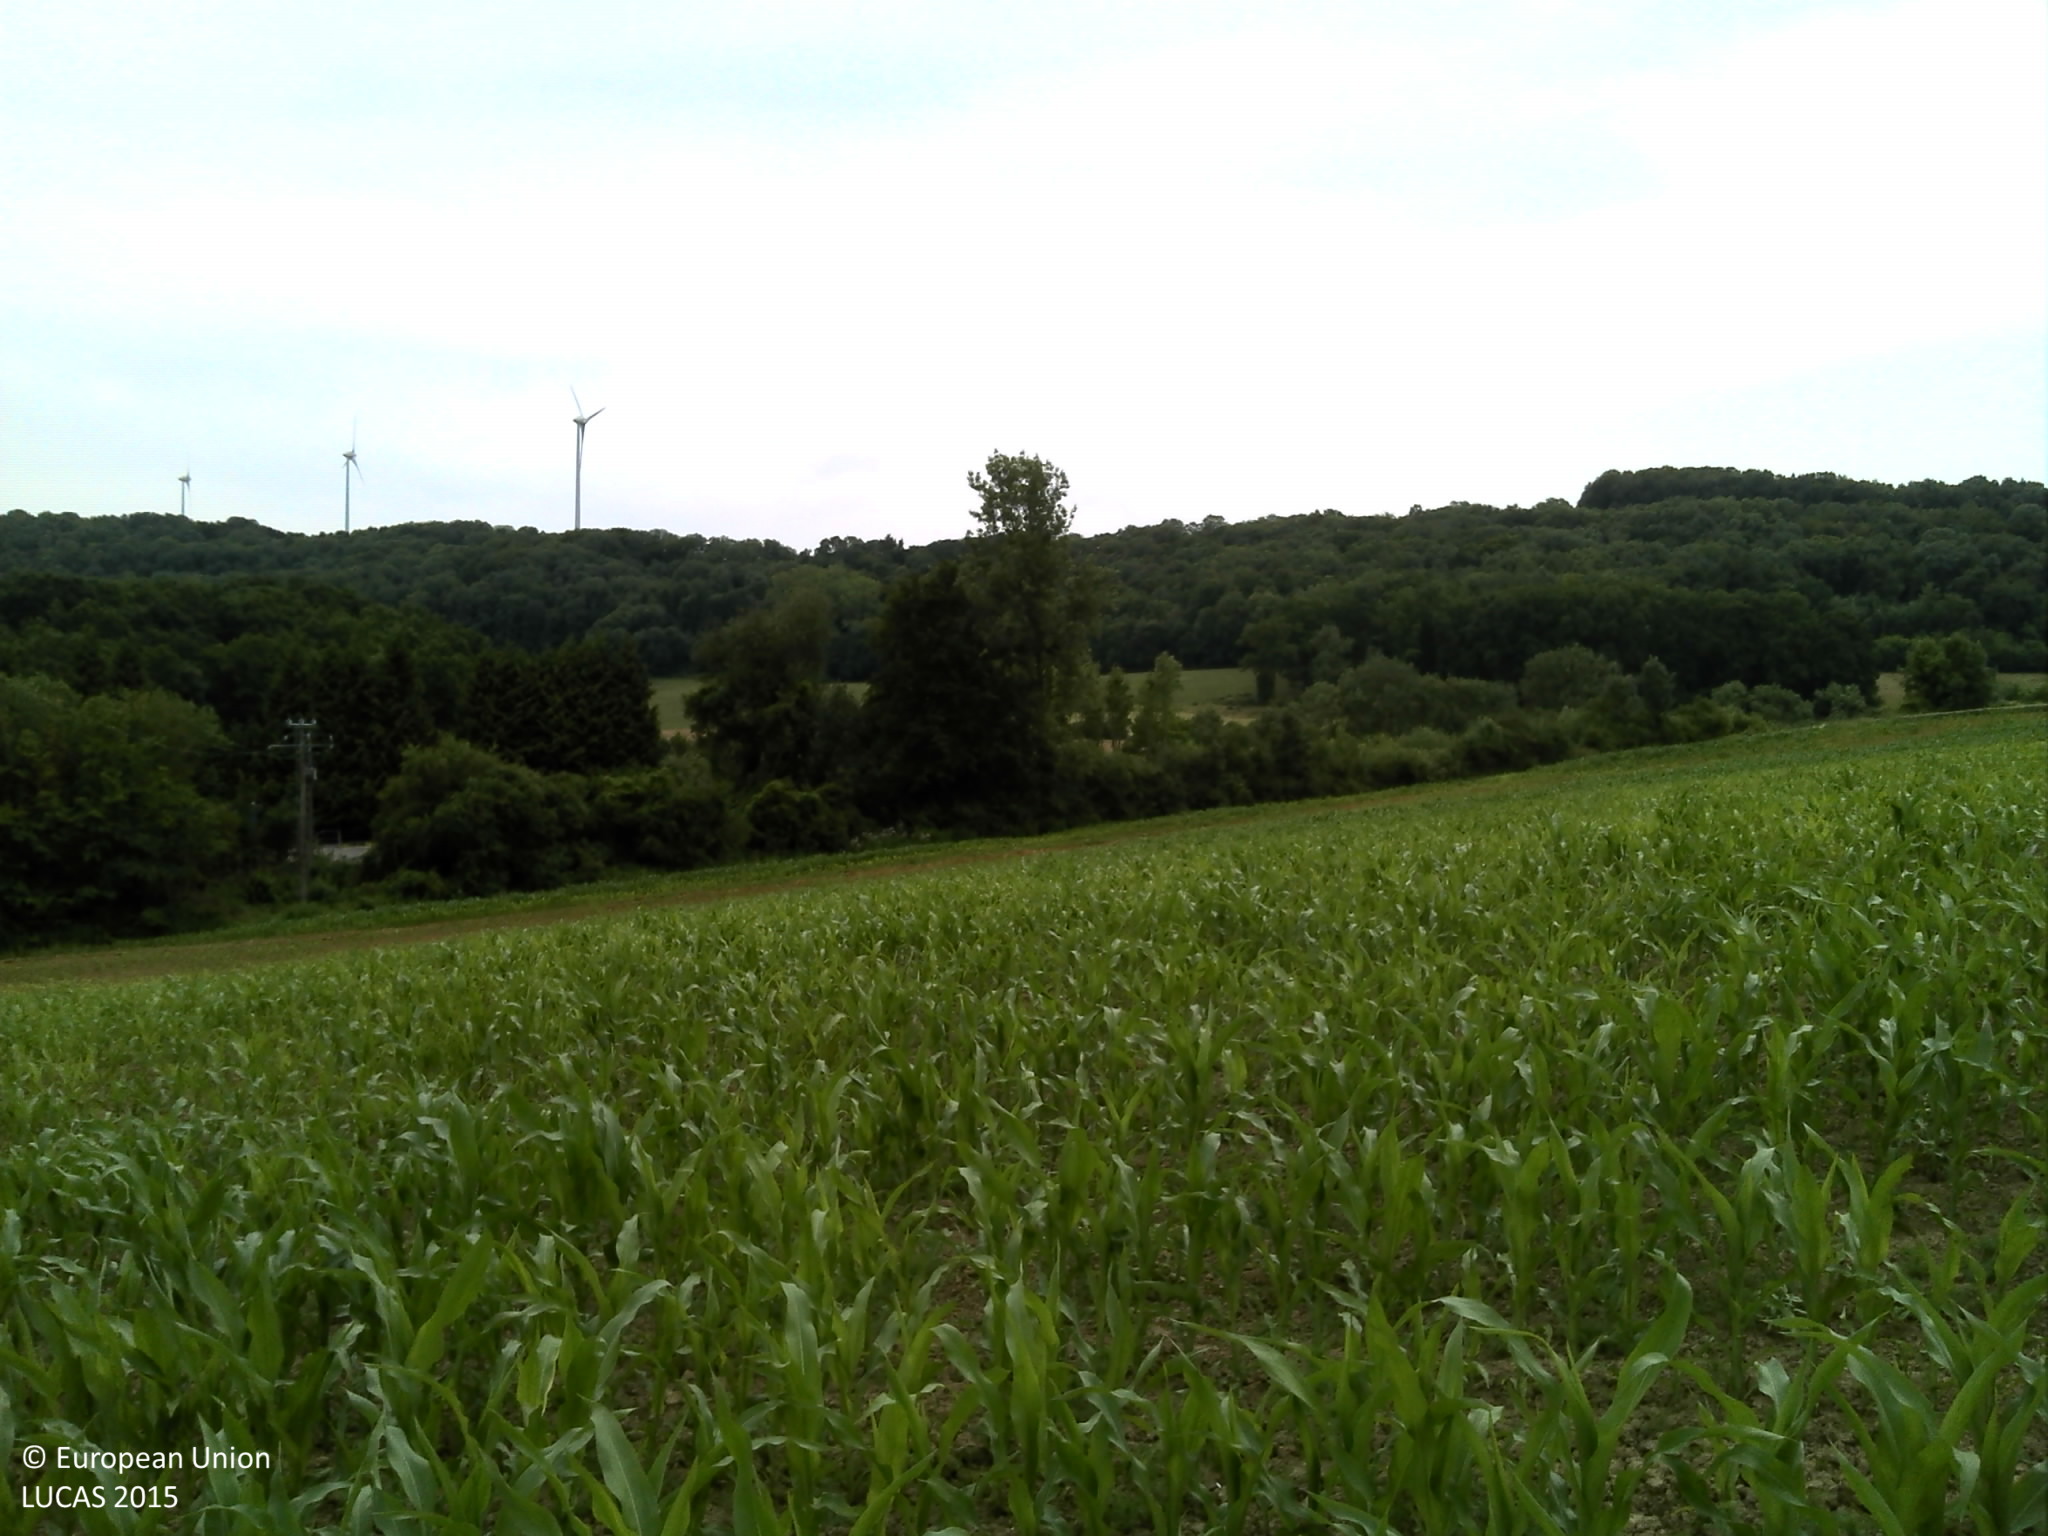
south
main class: Cropland
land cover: Maize
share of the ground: 25 - 50 %
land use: Agriculture (excluding fallow land and kitchen gardens)
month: June
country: FR
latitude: 49.6110
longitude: 5.1124
